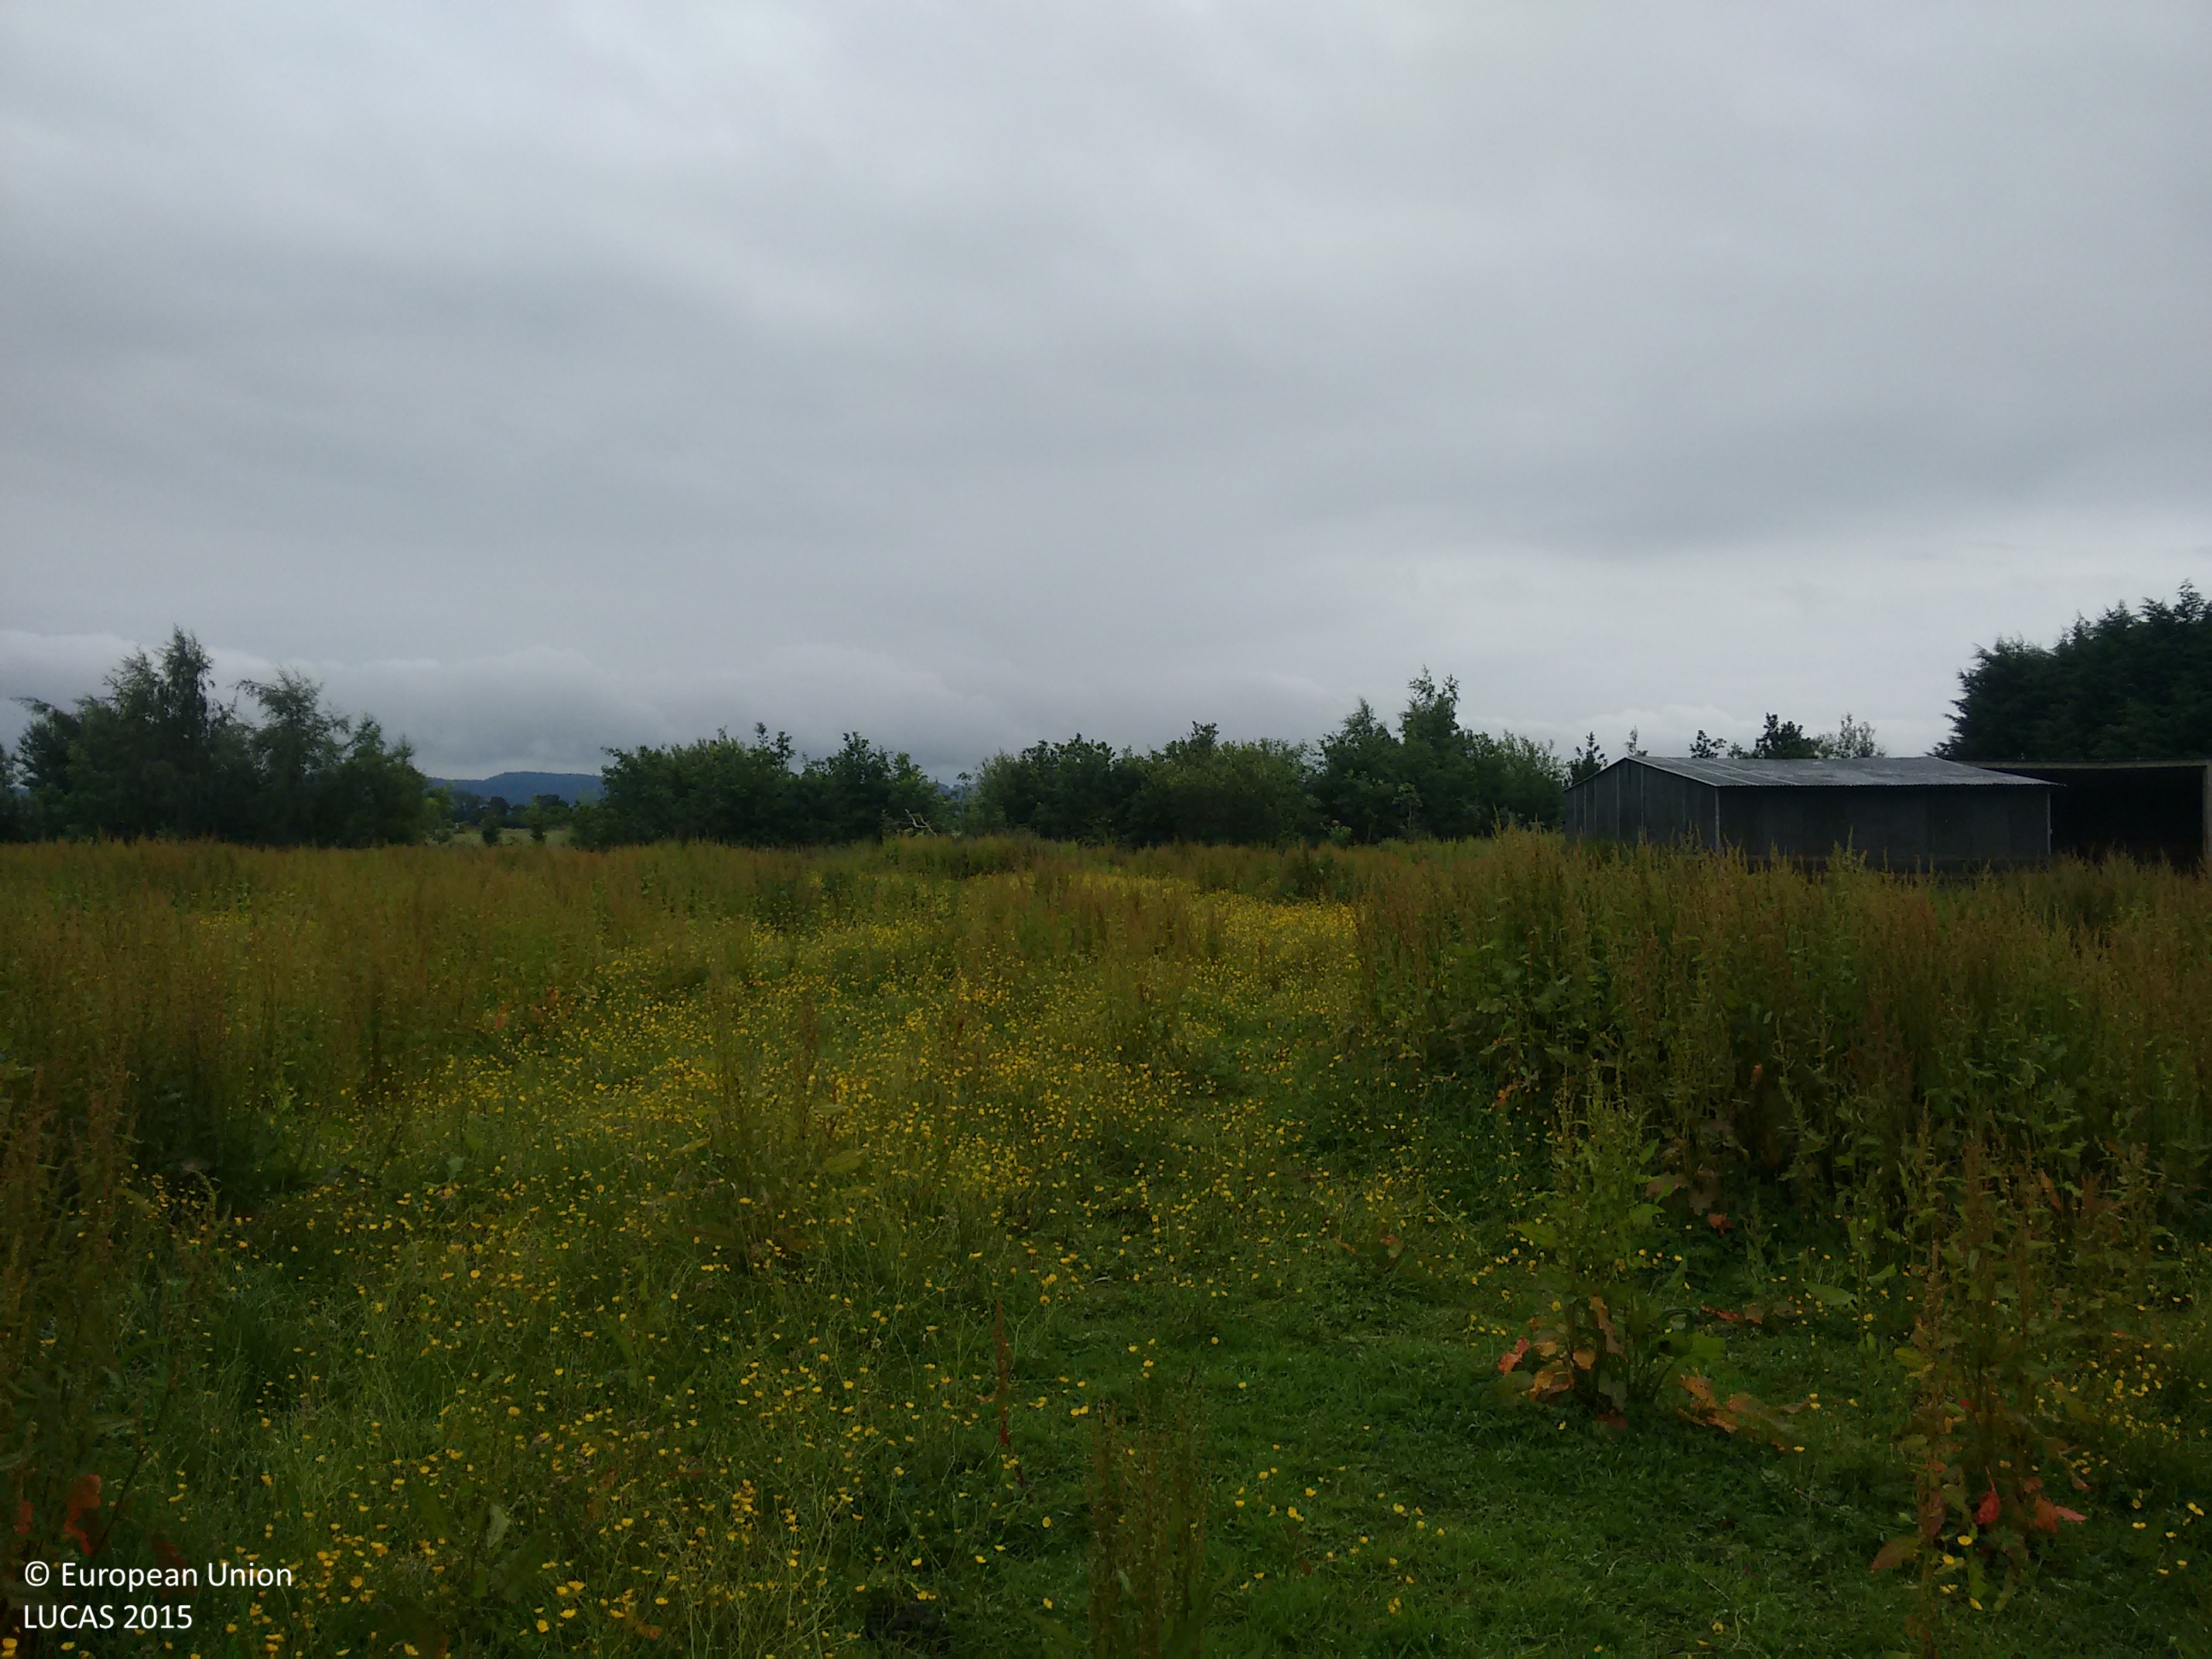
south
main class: Woodland
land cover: Broadleaved woodland
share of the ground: > 75 %
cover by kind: herbaceous plants 80 %, broadleaved forest trees 20 %
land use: Agriculture (excluding fallow land and kitchen gardens)
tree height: > 5 m
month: July
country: GB
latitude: 56.4403
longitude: -3.1253
